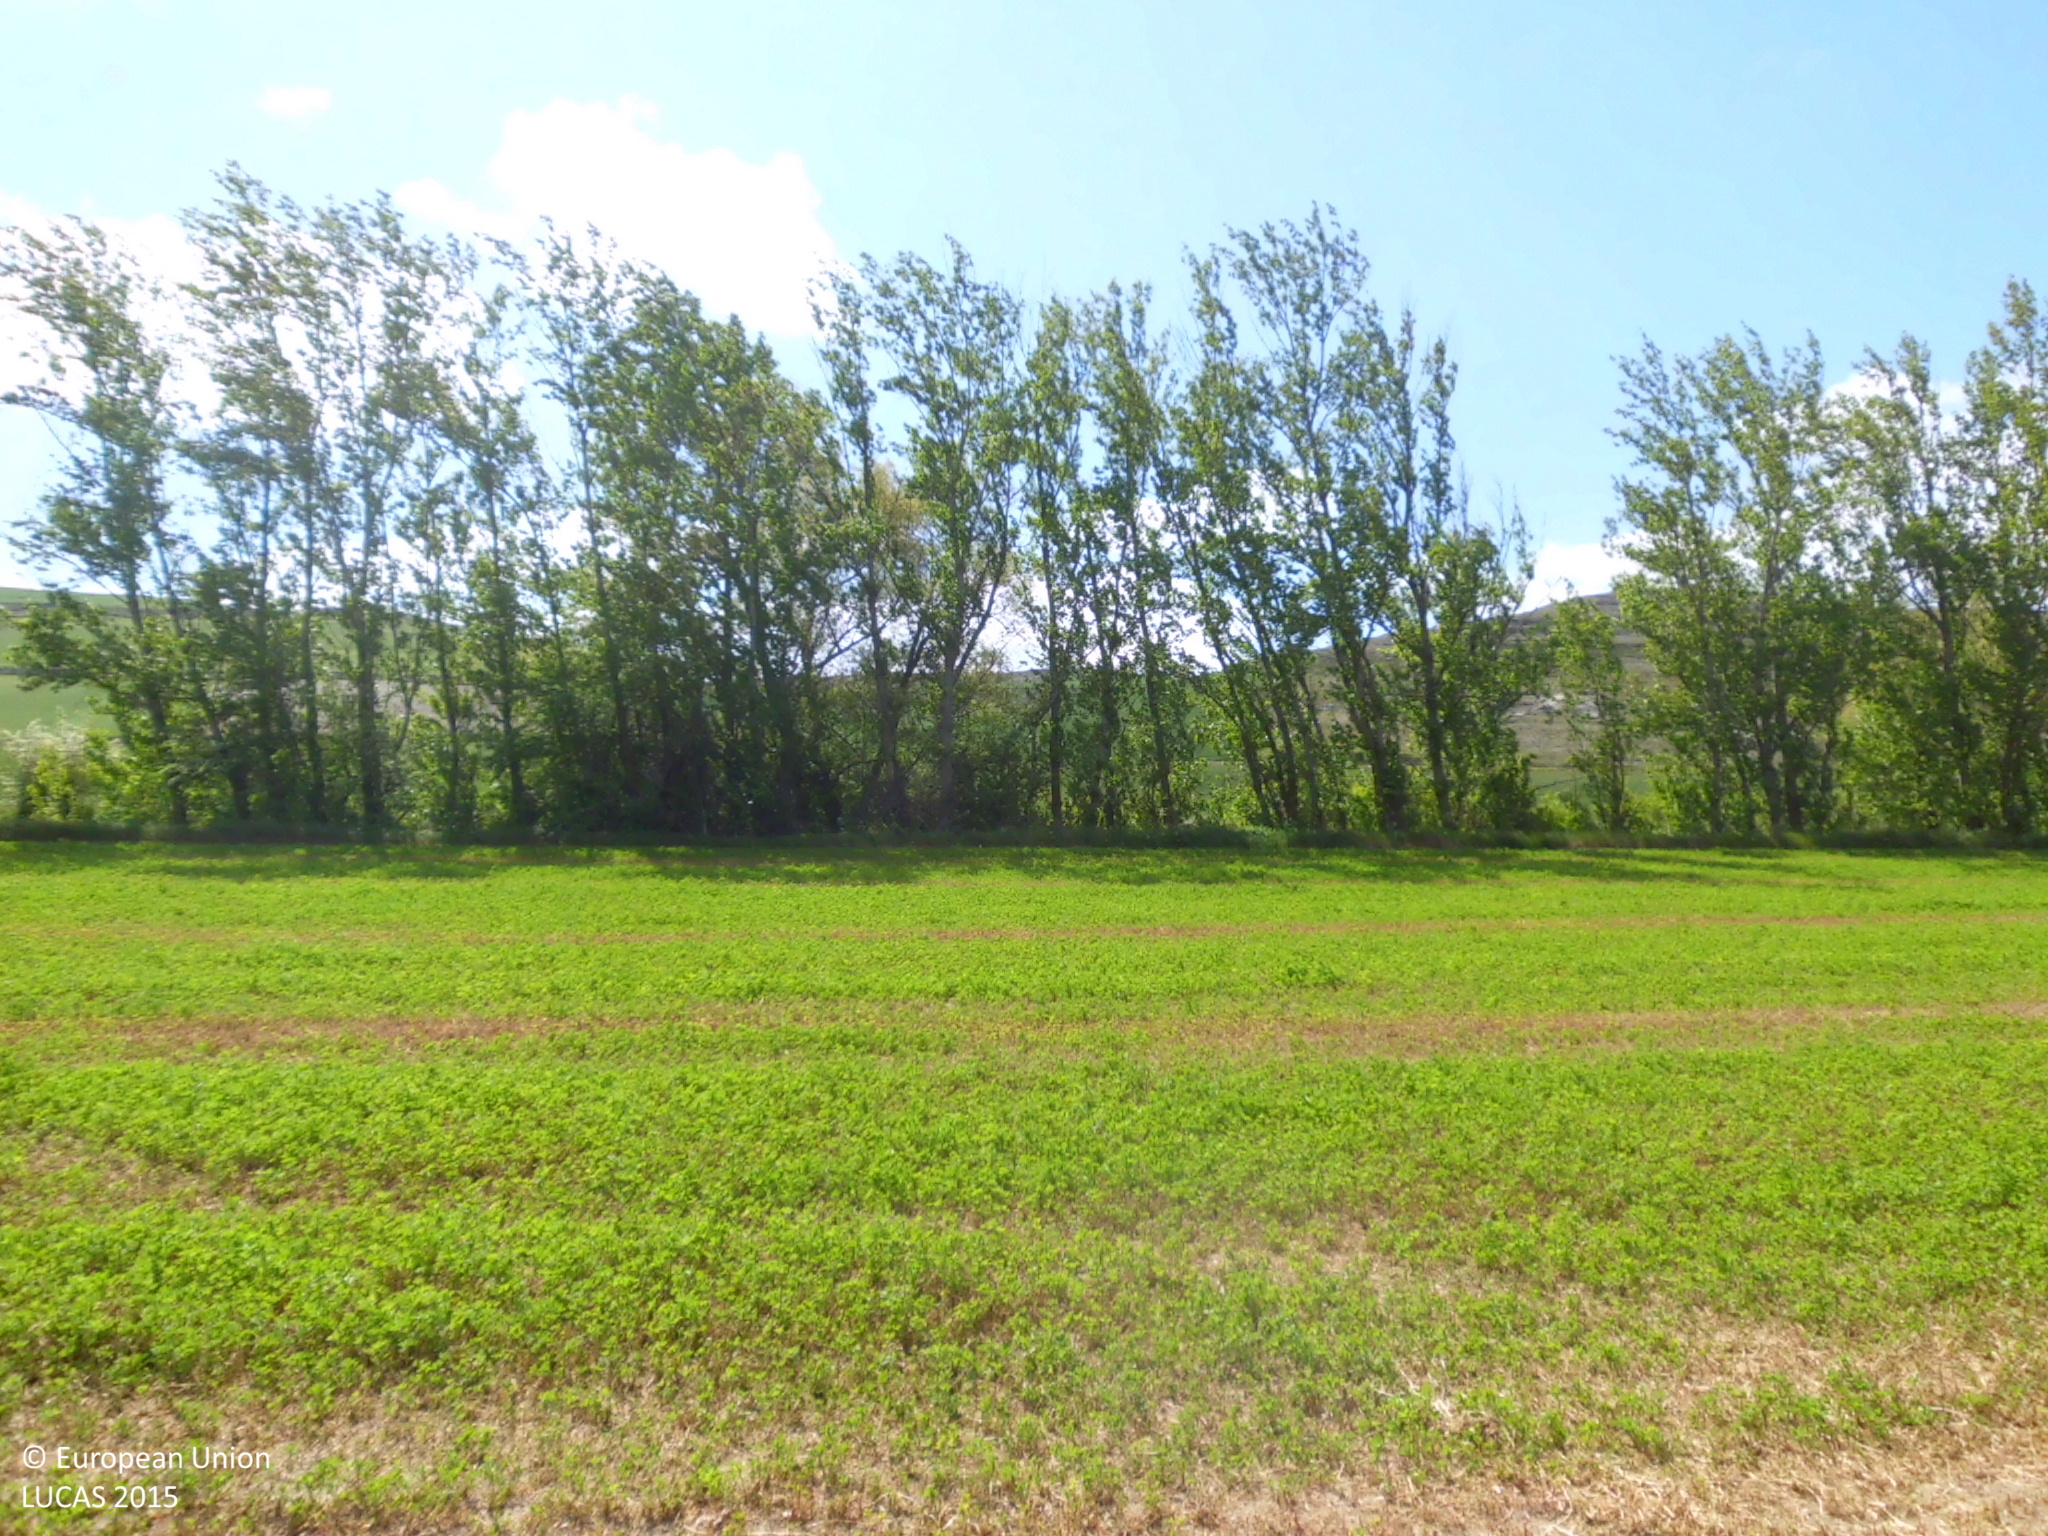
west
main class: Cropland
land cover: Lucerne
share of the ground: > 75 %
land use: Agriculture (excluding fallow land and kitchen gardens)
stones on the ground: 10 - 25 %
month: May
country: ES
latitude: 42.4179
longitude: -3.9311
